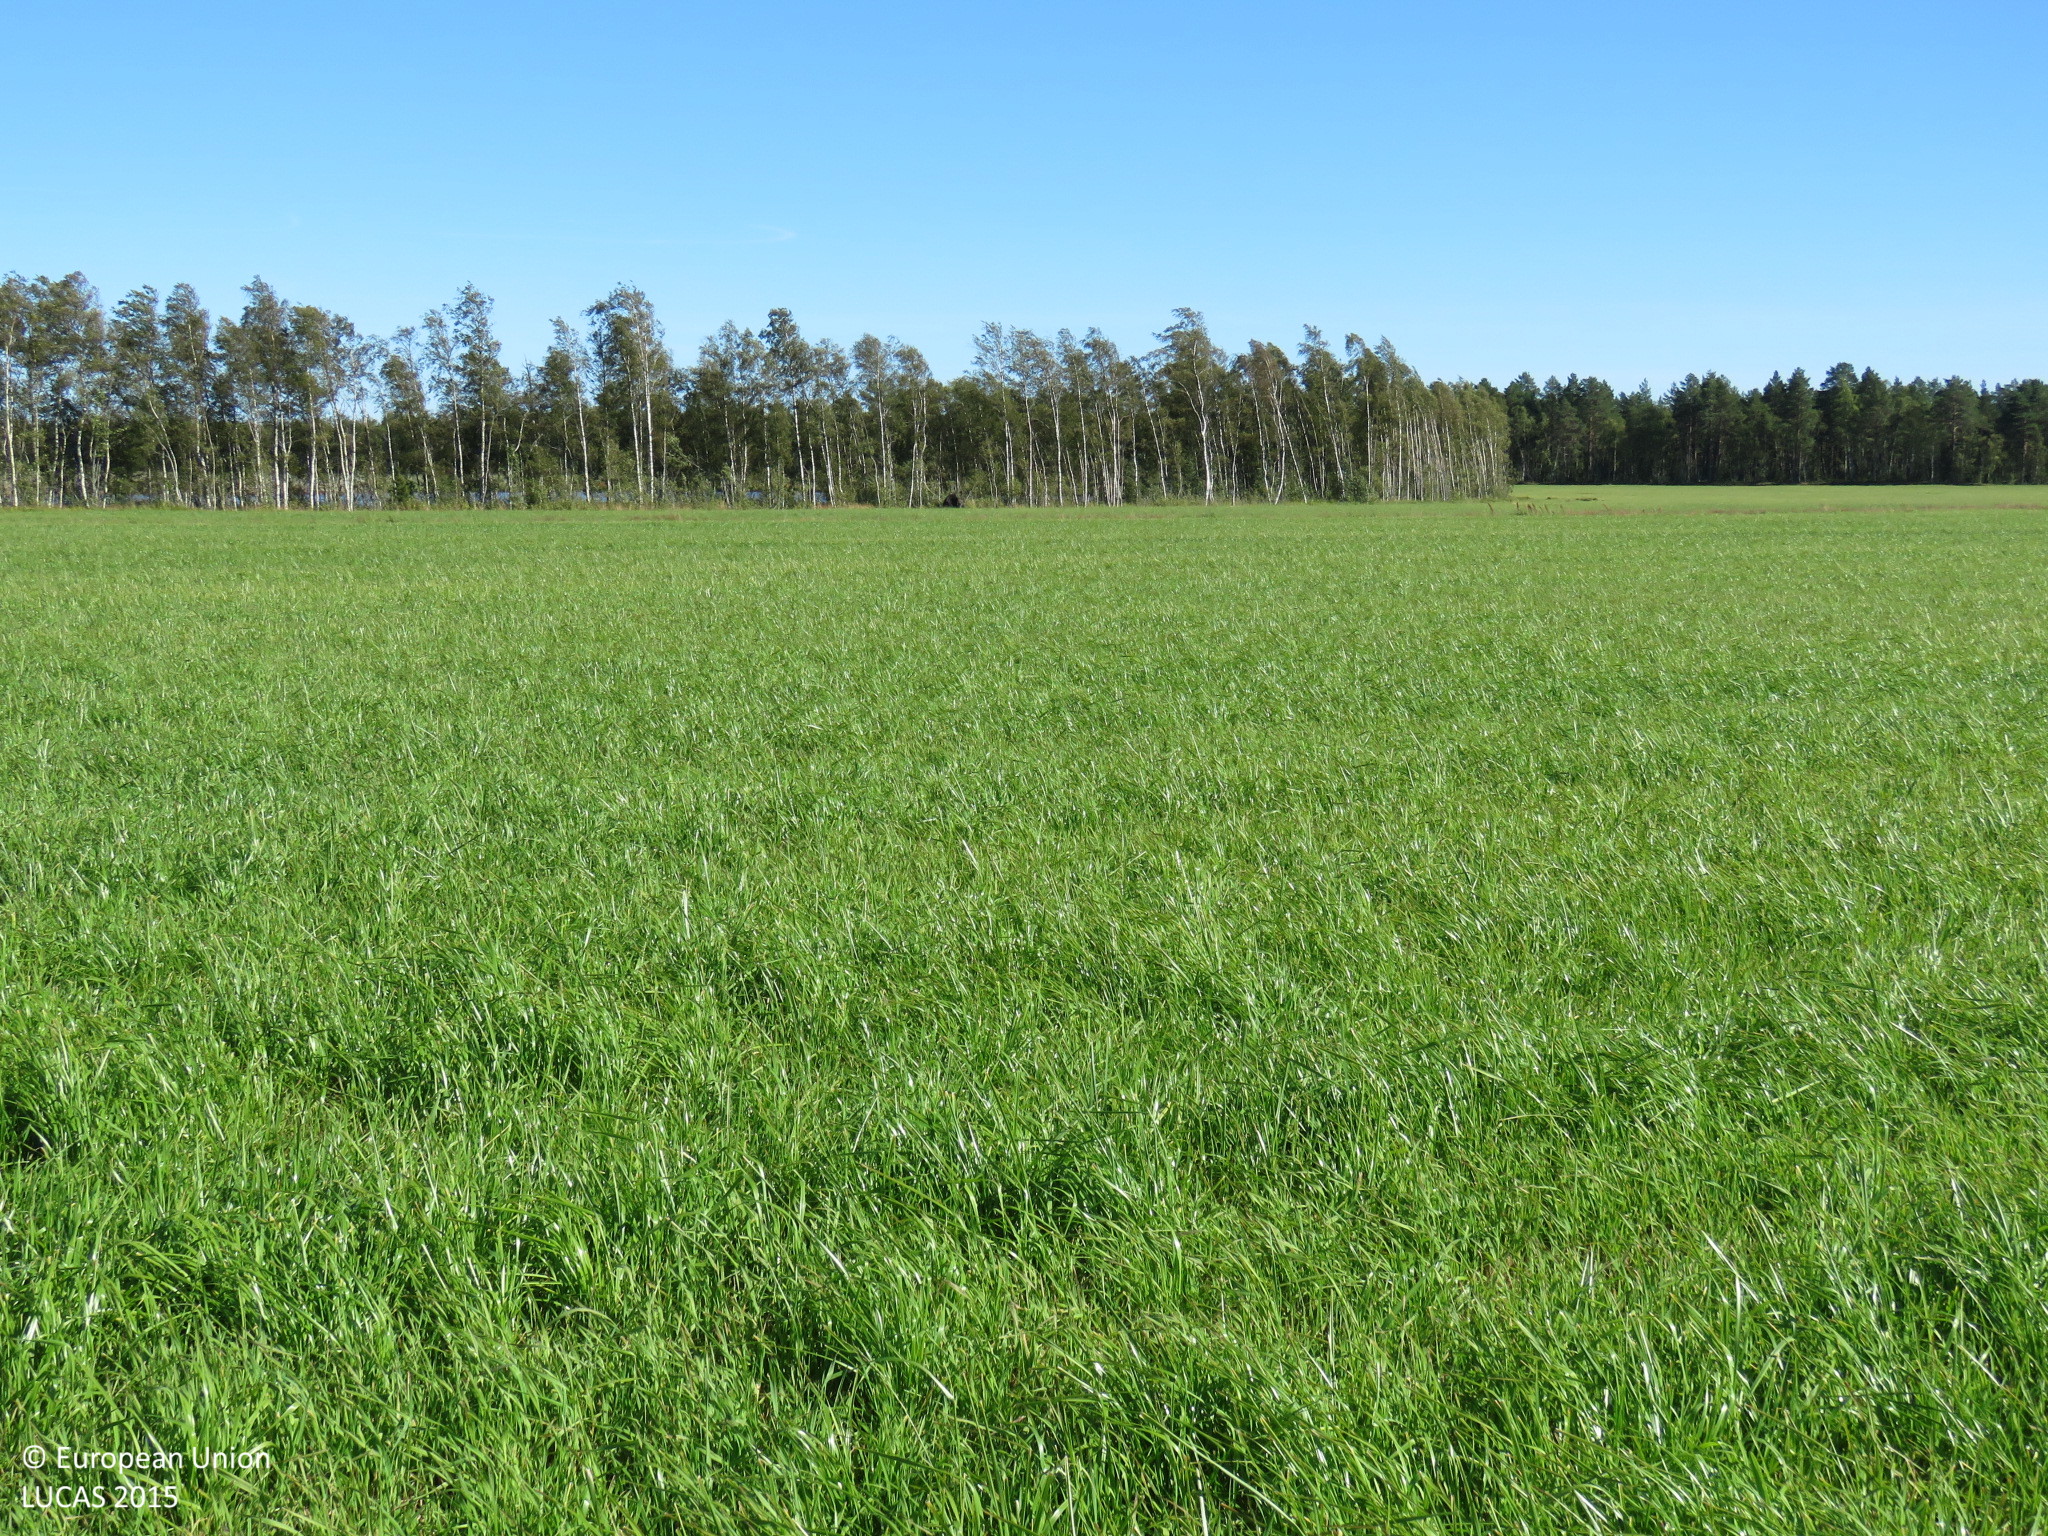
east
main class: Cropland
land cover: Temporary grasslands
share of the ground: > 75 %
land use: Agriculture (excluding fallow land and kitchen gardens)
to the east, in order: Temporary grasslands; Ditches and canals; Temporary grasslands; Ditches and canals; Broadleaved woodland; Peatbogs; Inland marshes; Inland fresh water bodies
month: August
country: FI
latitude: 65.0255
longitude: 24.8219
